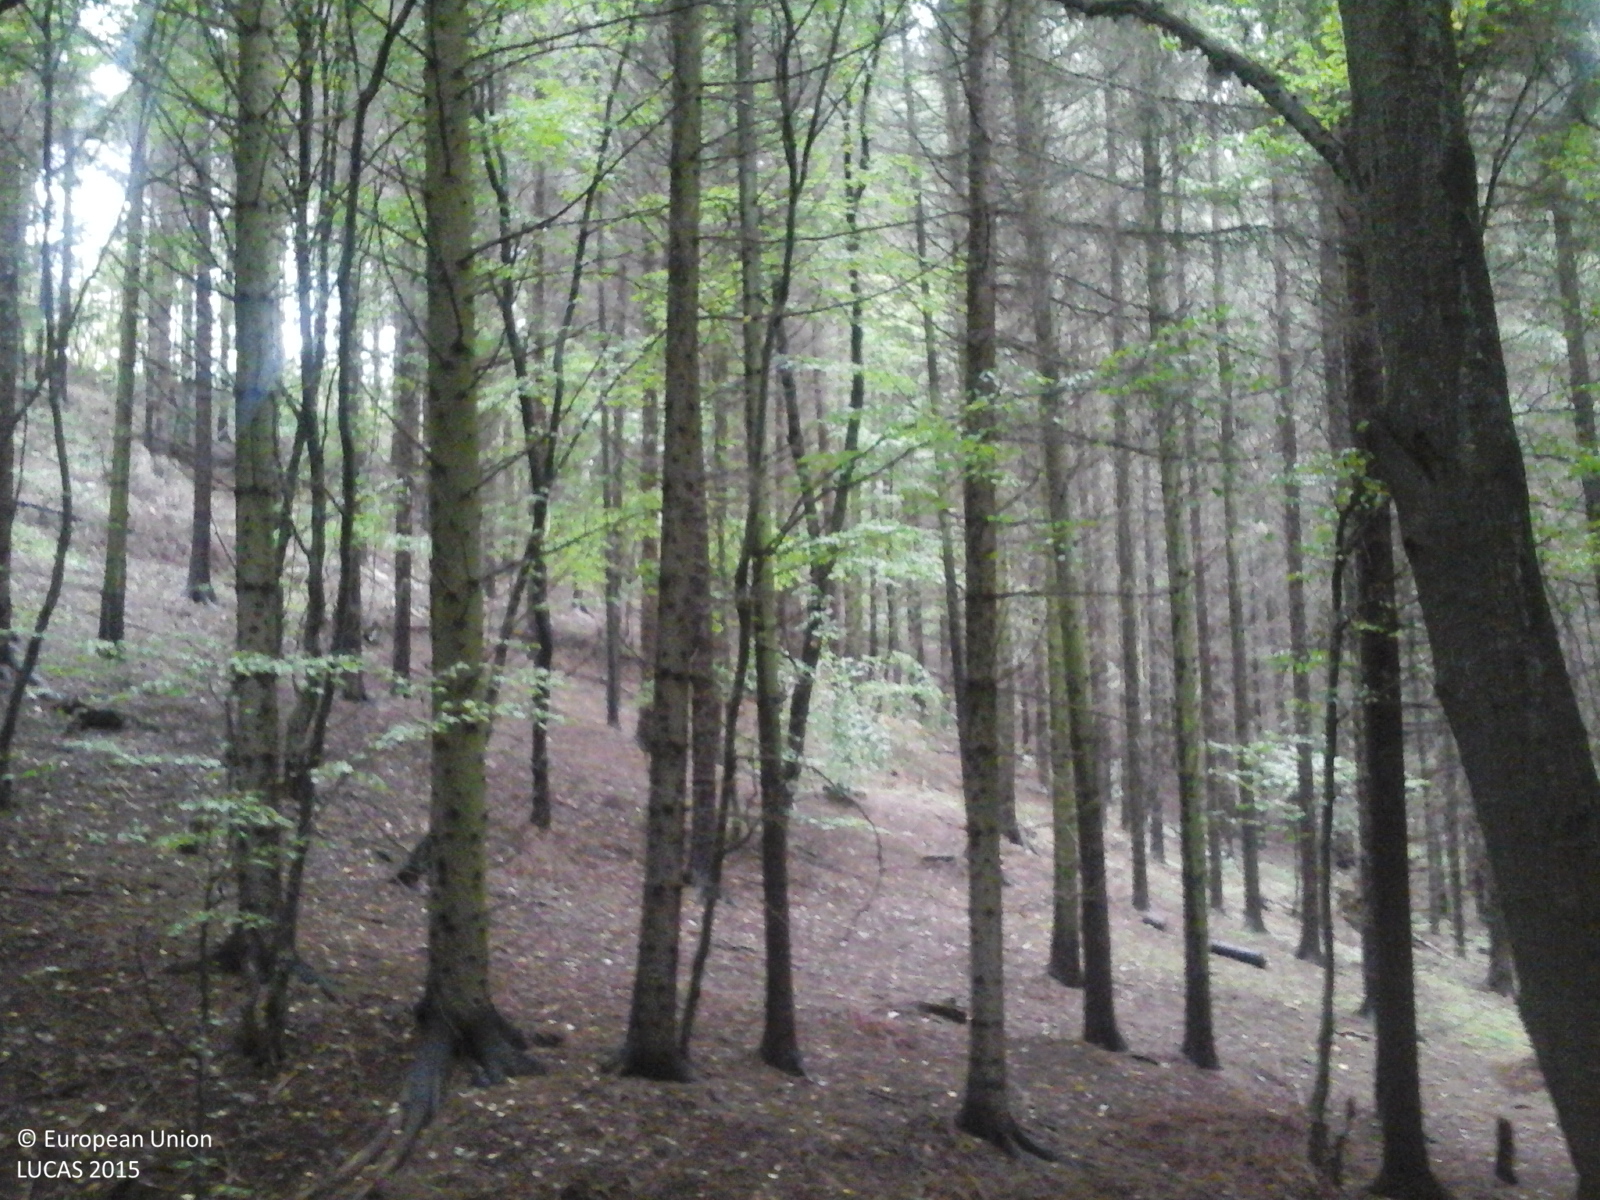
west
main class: Woodland
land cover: Other mixed woodland
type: beech forest
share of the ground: > 75 %
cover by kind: broadleaved forest trees 70 %, coniferous forest trees 30 %
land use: Forestry
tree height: > 5 m
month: September
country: RO
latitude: 45.8090
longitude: 23.7202
